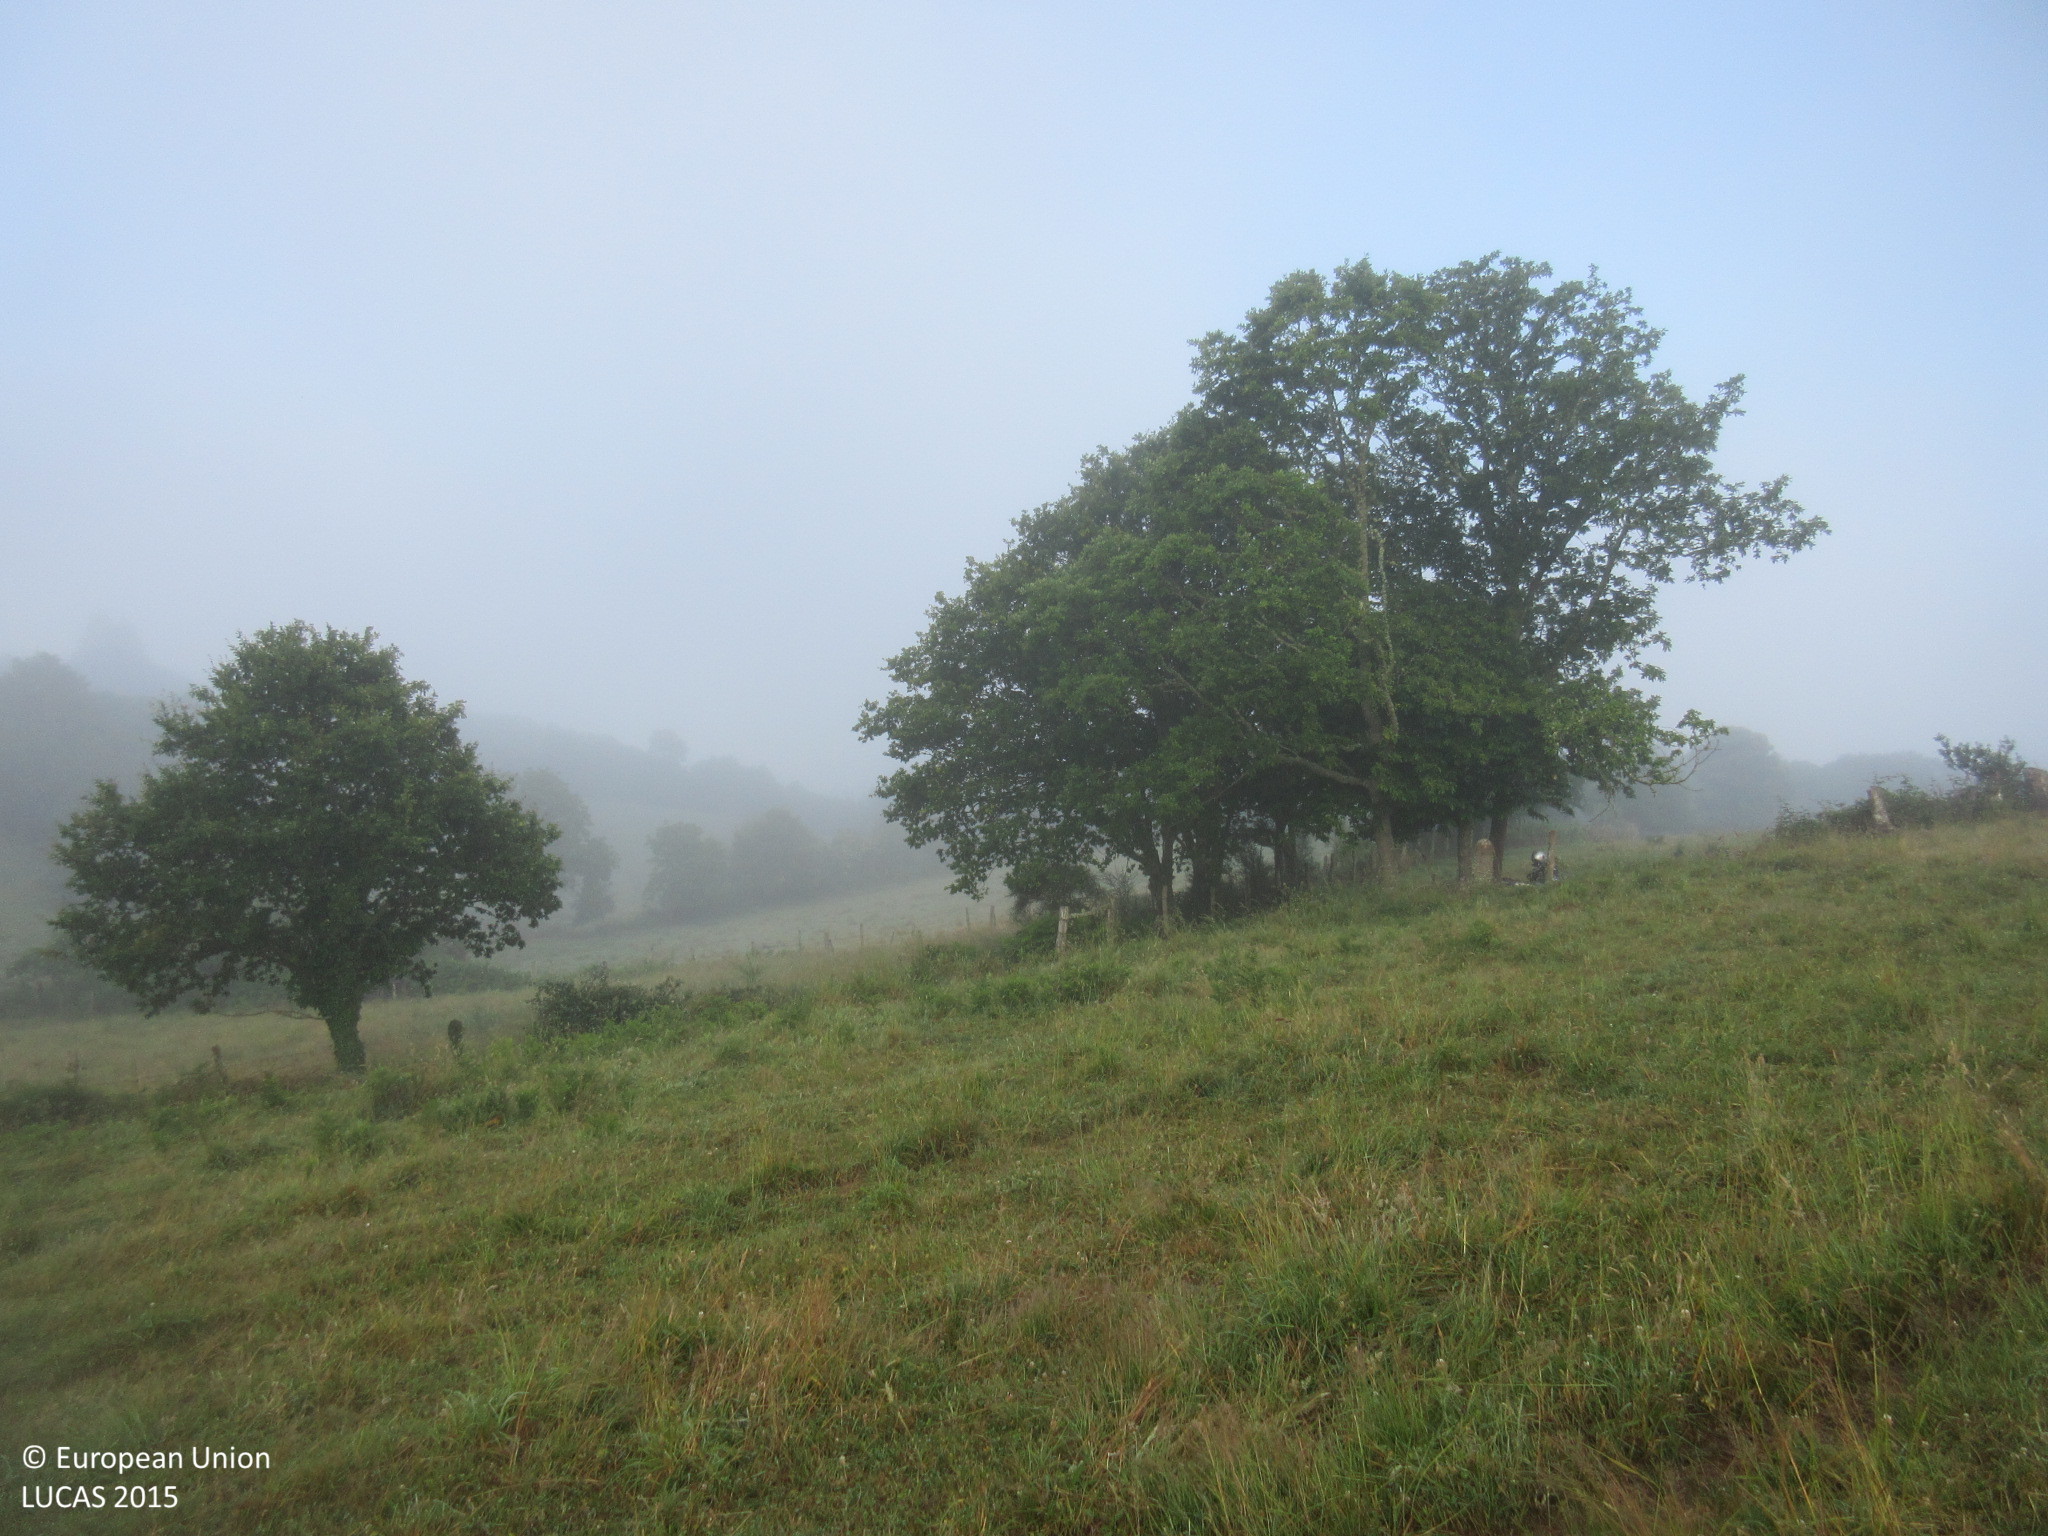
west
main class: Grassland
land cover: Grassland without tree/shrub cover
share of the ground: > 75 %
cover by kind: herbaceous plants 100 %
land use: Agriculture (excluding fallow land and kitchen gardens)
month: June
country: ES
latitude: 43.2534
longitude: -7.0776
